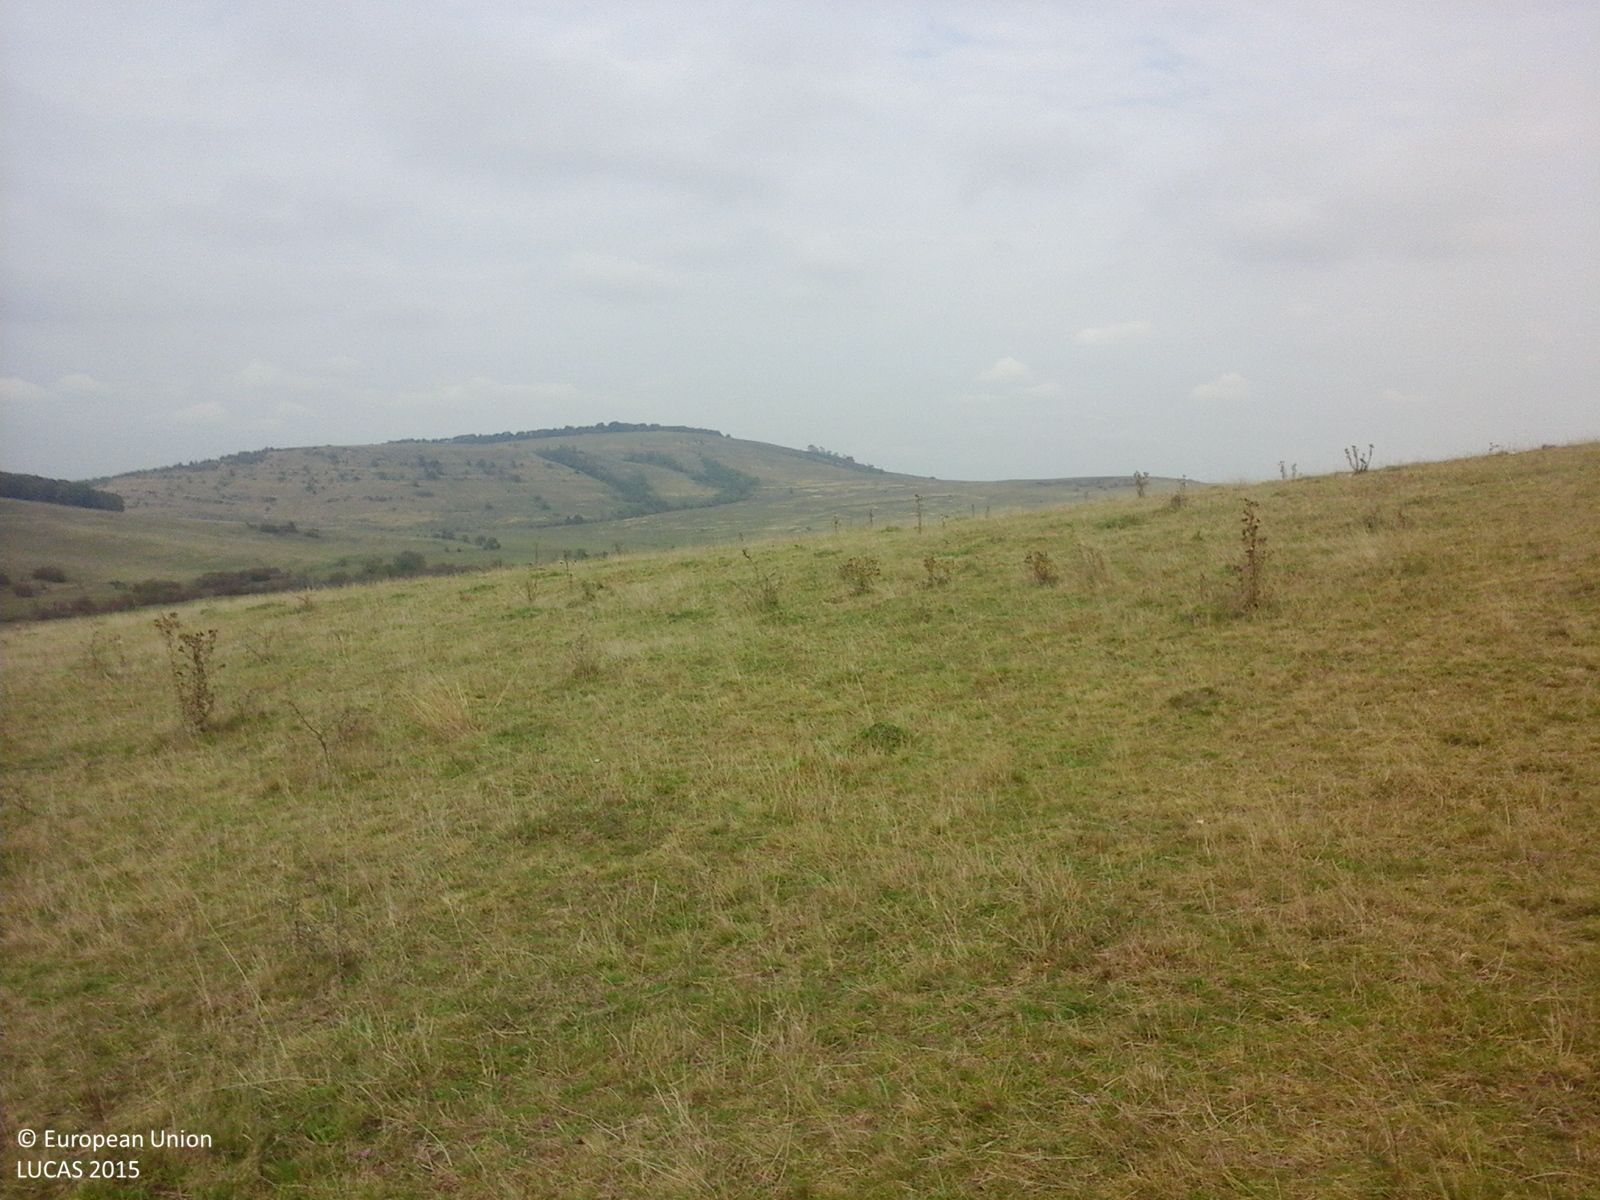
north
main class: Grassland
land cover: Grassland without tree/shrub cover
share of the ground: > 75 %
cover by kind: herbaceous plants 100 %
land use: Agriculture (excluding fallow land and kitchen gardens)
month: October
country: RO
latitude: 46.0753
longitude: 25.2406
